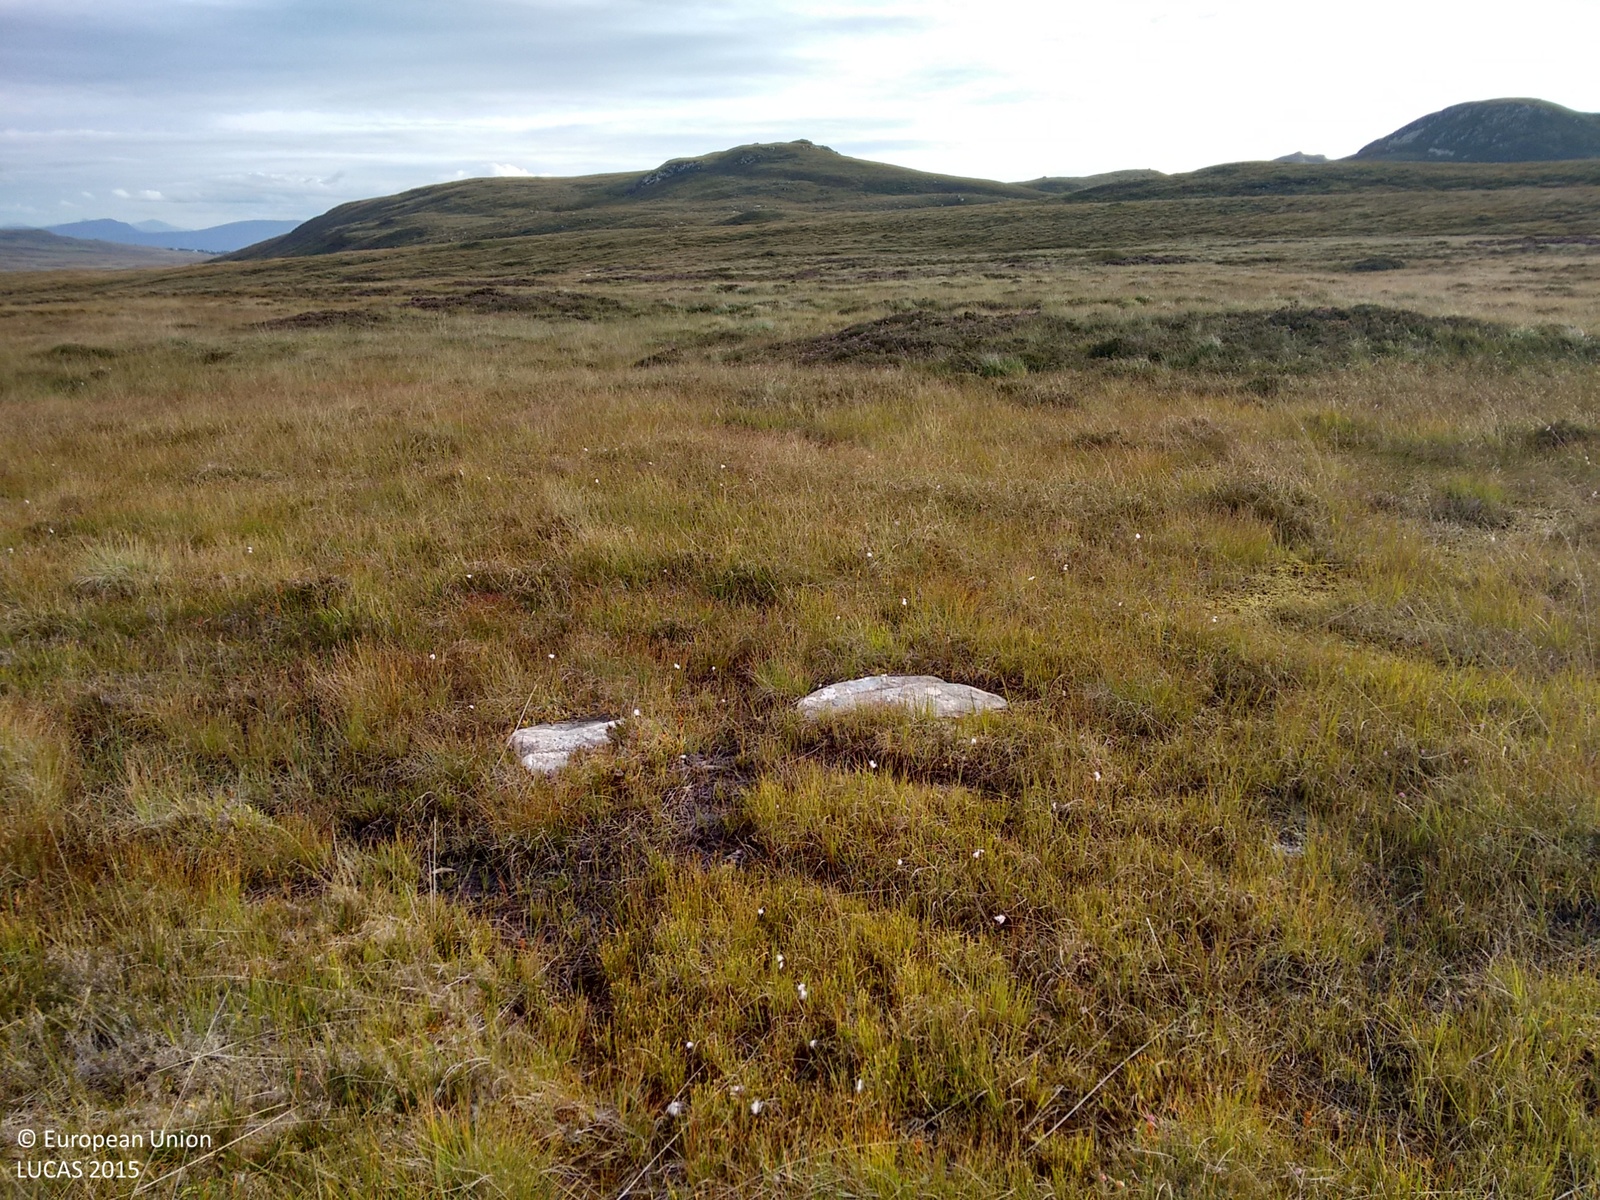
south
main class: Shrubland
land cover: Shrubland without tree cover
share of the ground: > 75 %
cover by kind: shrubs 75 %, herbaceous plants 25 %
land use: Agriculture (excluding fallow land and kitchen gardens)
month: September
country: GB
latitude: 58.0611
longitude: -5.3789
